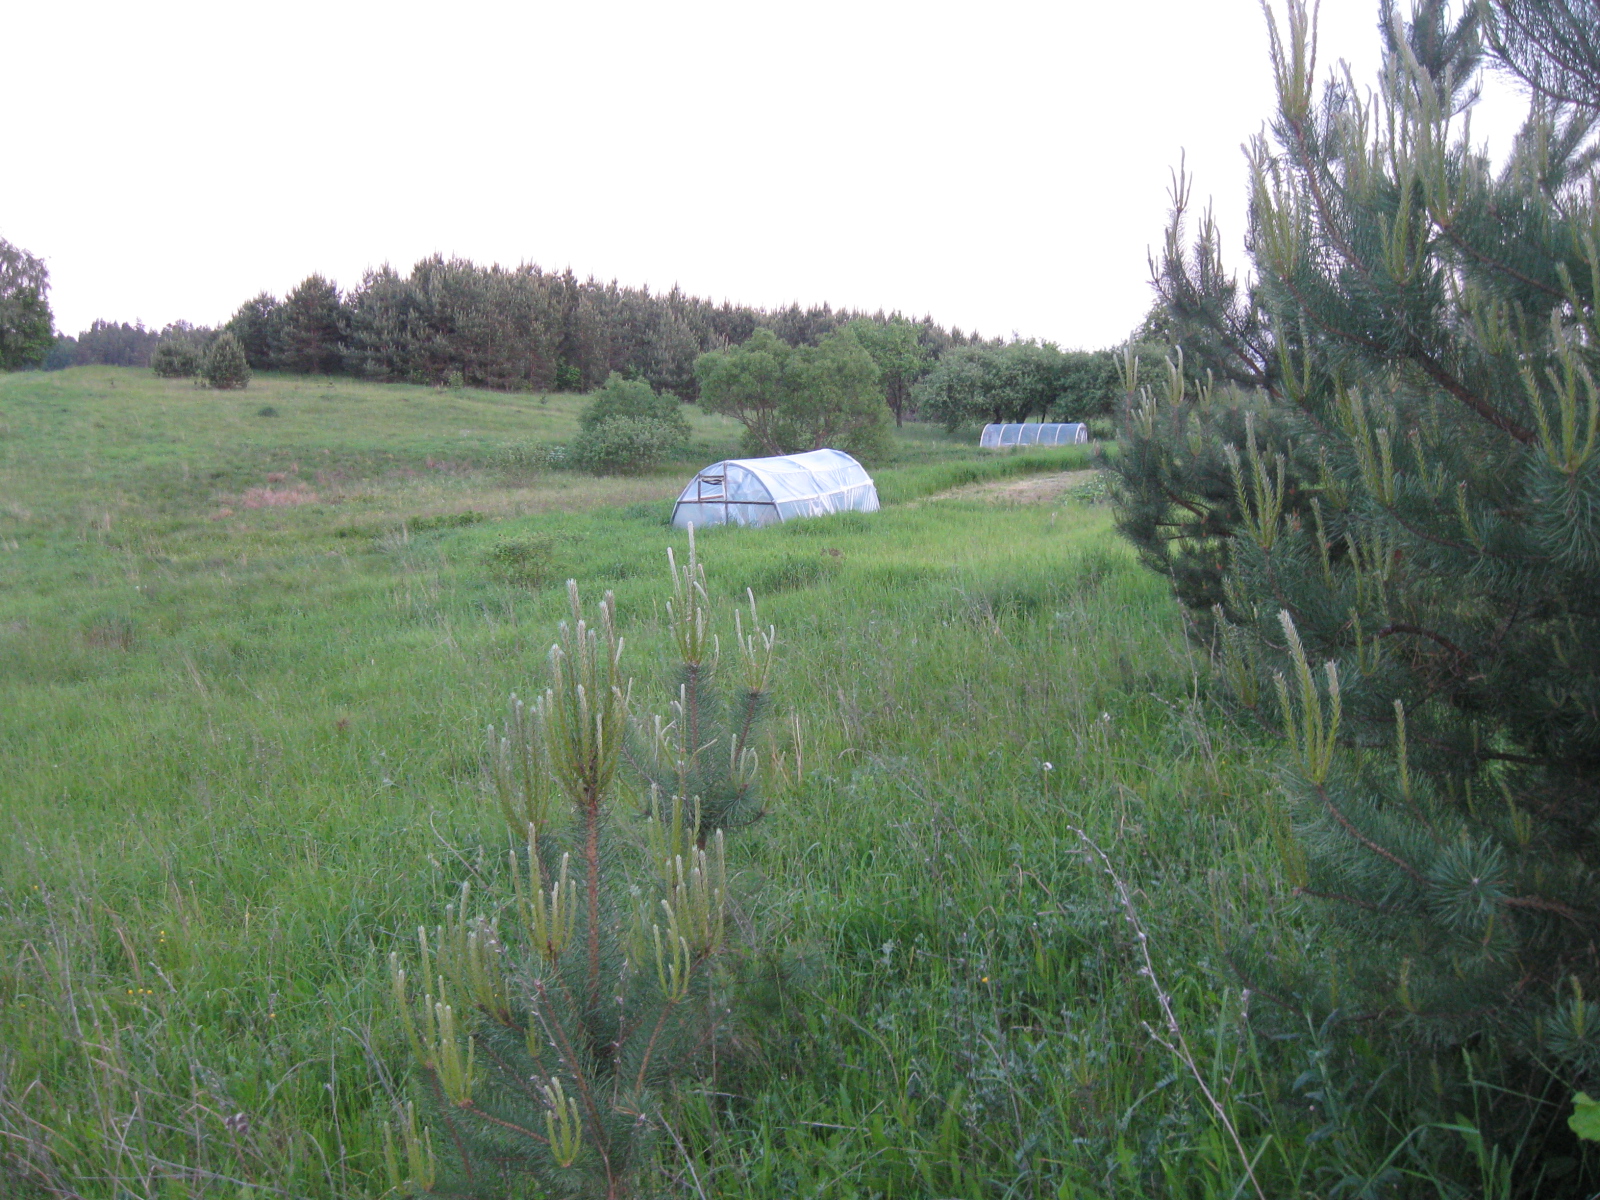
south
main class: Woodland
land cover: Pine dominated coniferous woodland
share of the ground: 25 - 50 %
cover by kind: herbaceous plants 65 %, coniferous forest trees 30 %, broadleaved forest trees 5 %
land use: Agriculture (excluding fallow land and kitchen gardens)
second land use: Forestry
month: June
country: LT
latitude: 54.1978
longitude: 23.7764
